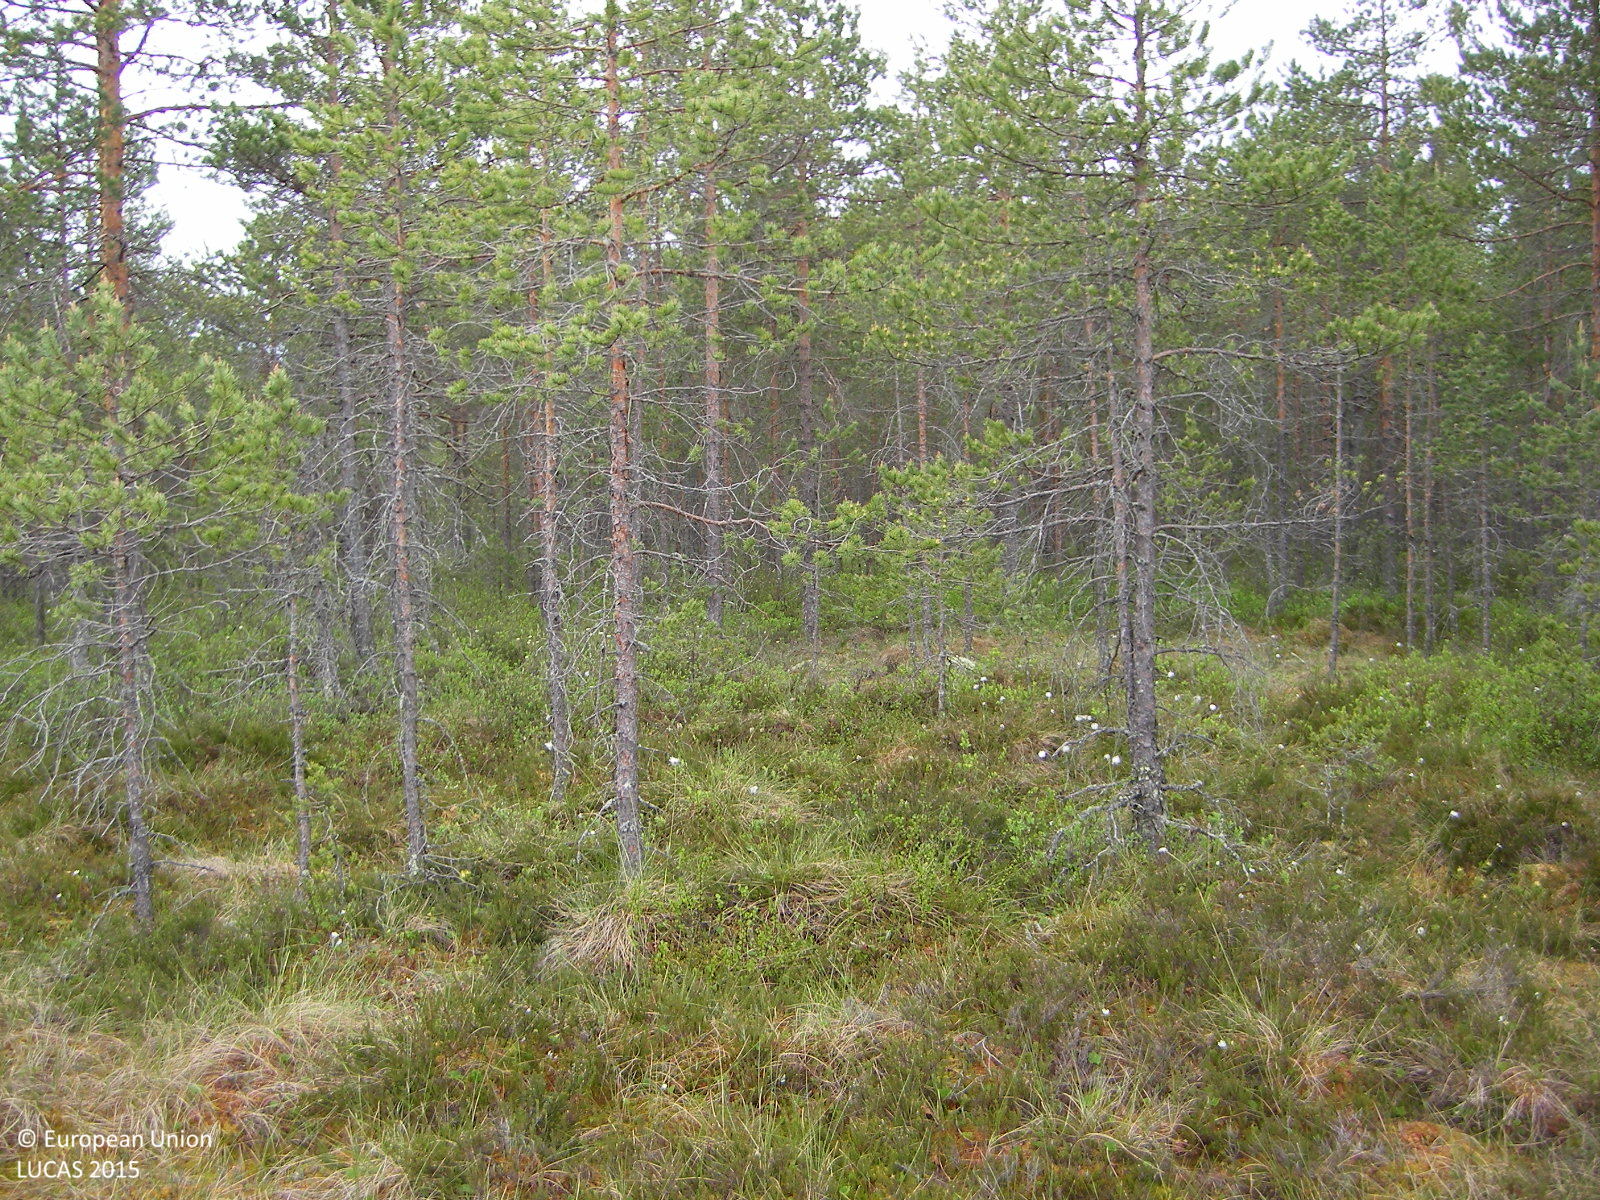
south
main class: Woodland
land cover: Pine dominated coniferous woodland
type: mire and swamp forests
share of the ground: 25 - 50 %
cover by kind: coniferous forest trees 45 %, shrubs 25 %, herbaceous plants 20 %, lichens and mosses 5 %, unconsolidated bare surface 5 %
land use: Semi-natural and natural areas not in use
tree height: < 5 m
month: June
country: FI
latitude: 60.3976
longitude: 24.6842
